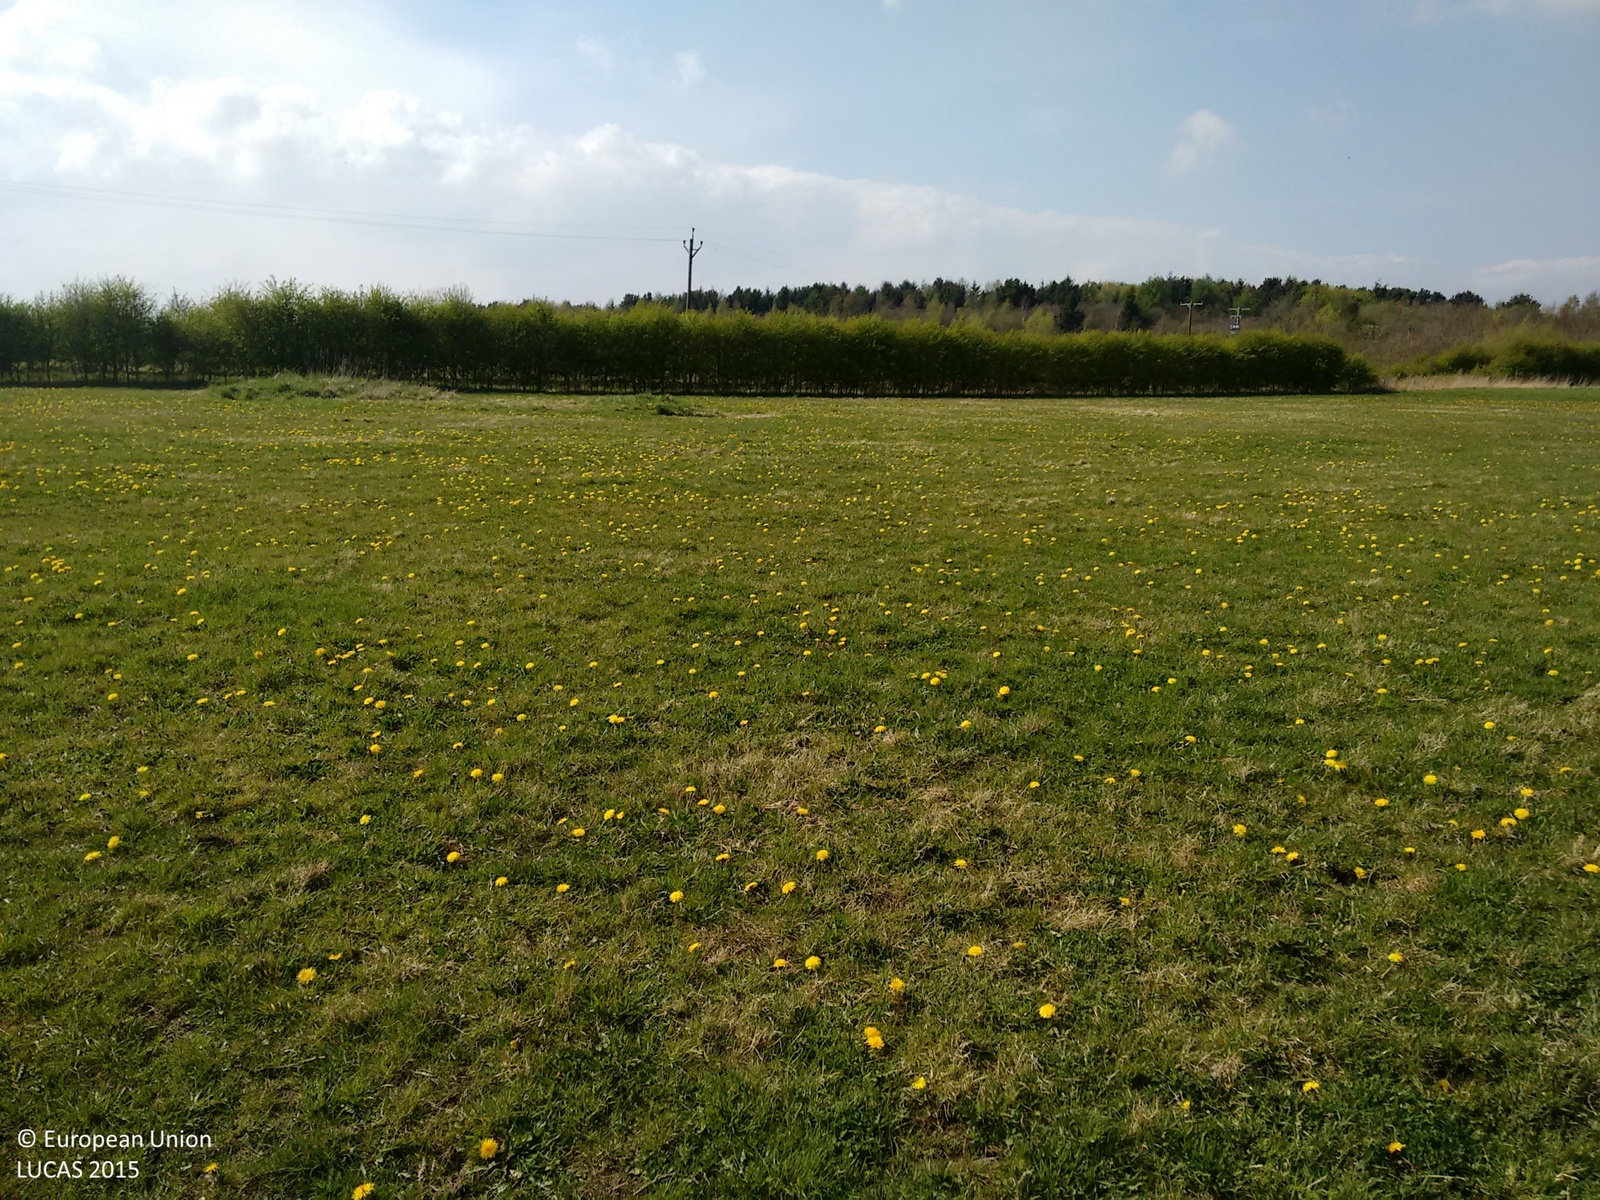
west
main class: Grassland
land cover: Grassland with sparse tree/shrub cover
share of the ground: > 75 %
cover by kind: herbaceous plants 95 %, broadleaved forest trees 5 %
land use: Agriculture (excluding fallow land and kitchen gardens)
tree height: > 5 m
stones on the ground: < 10 %
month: April
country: GB
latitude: 55.0373
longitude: -1.6440
